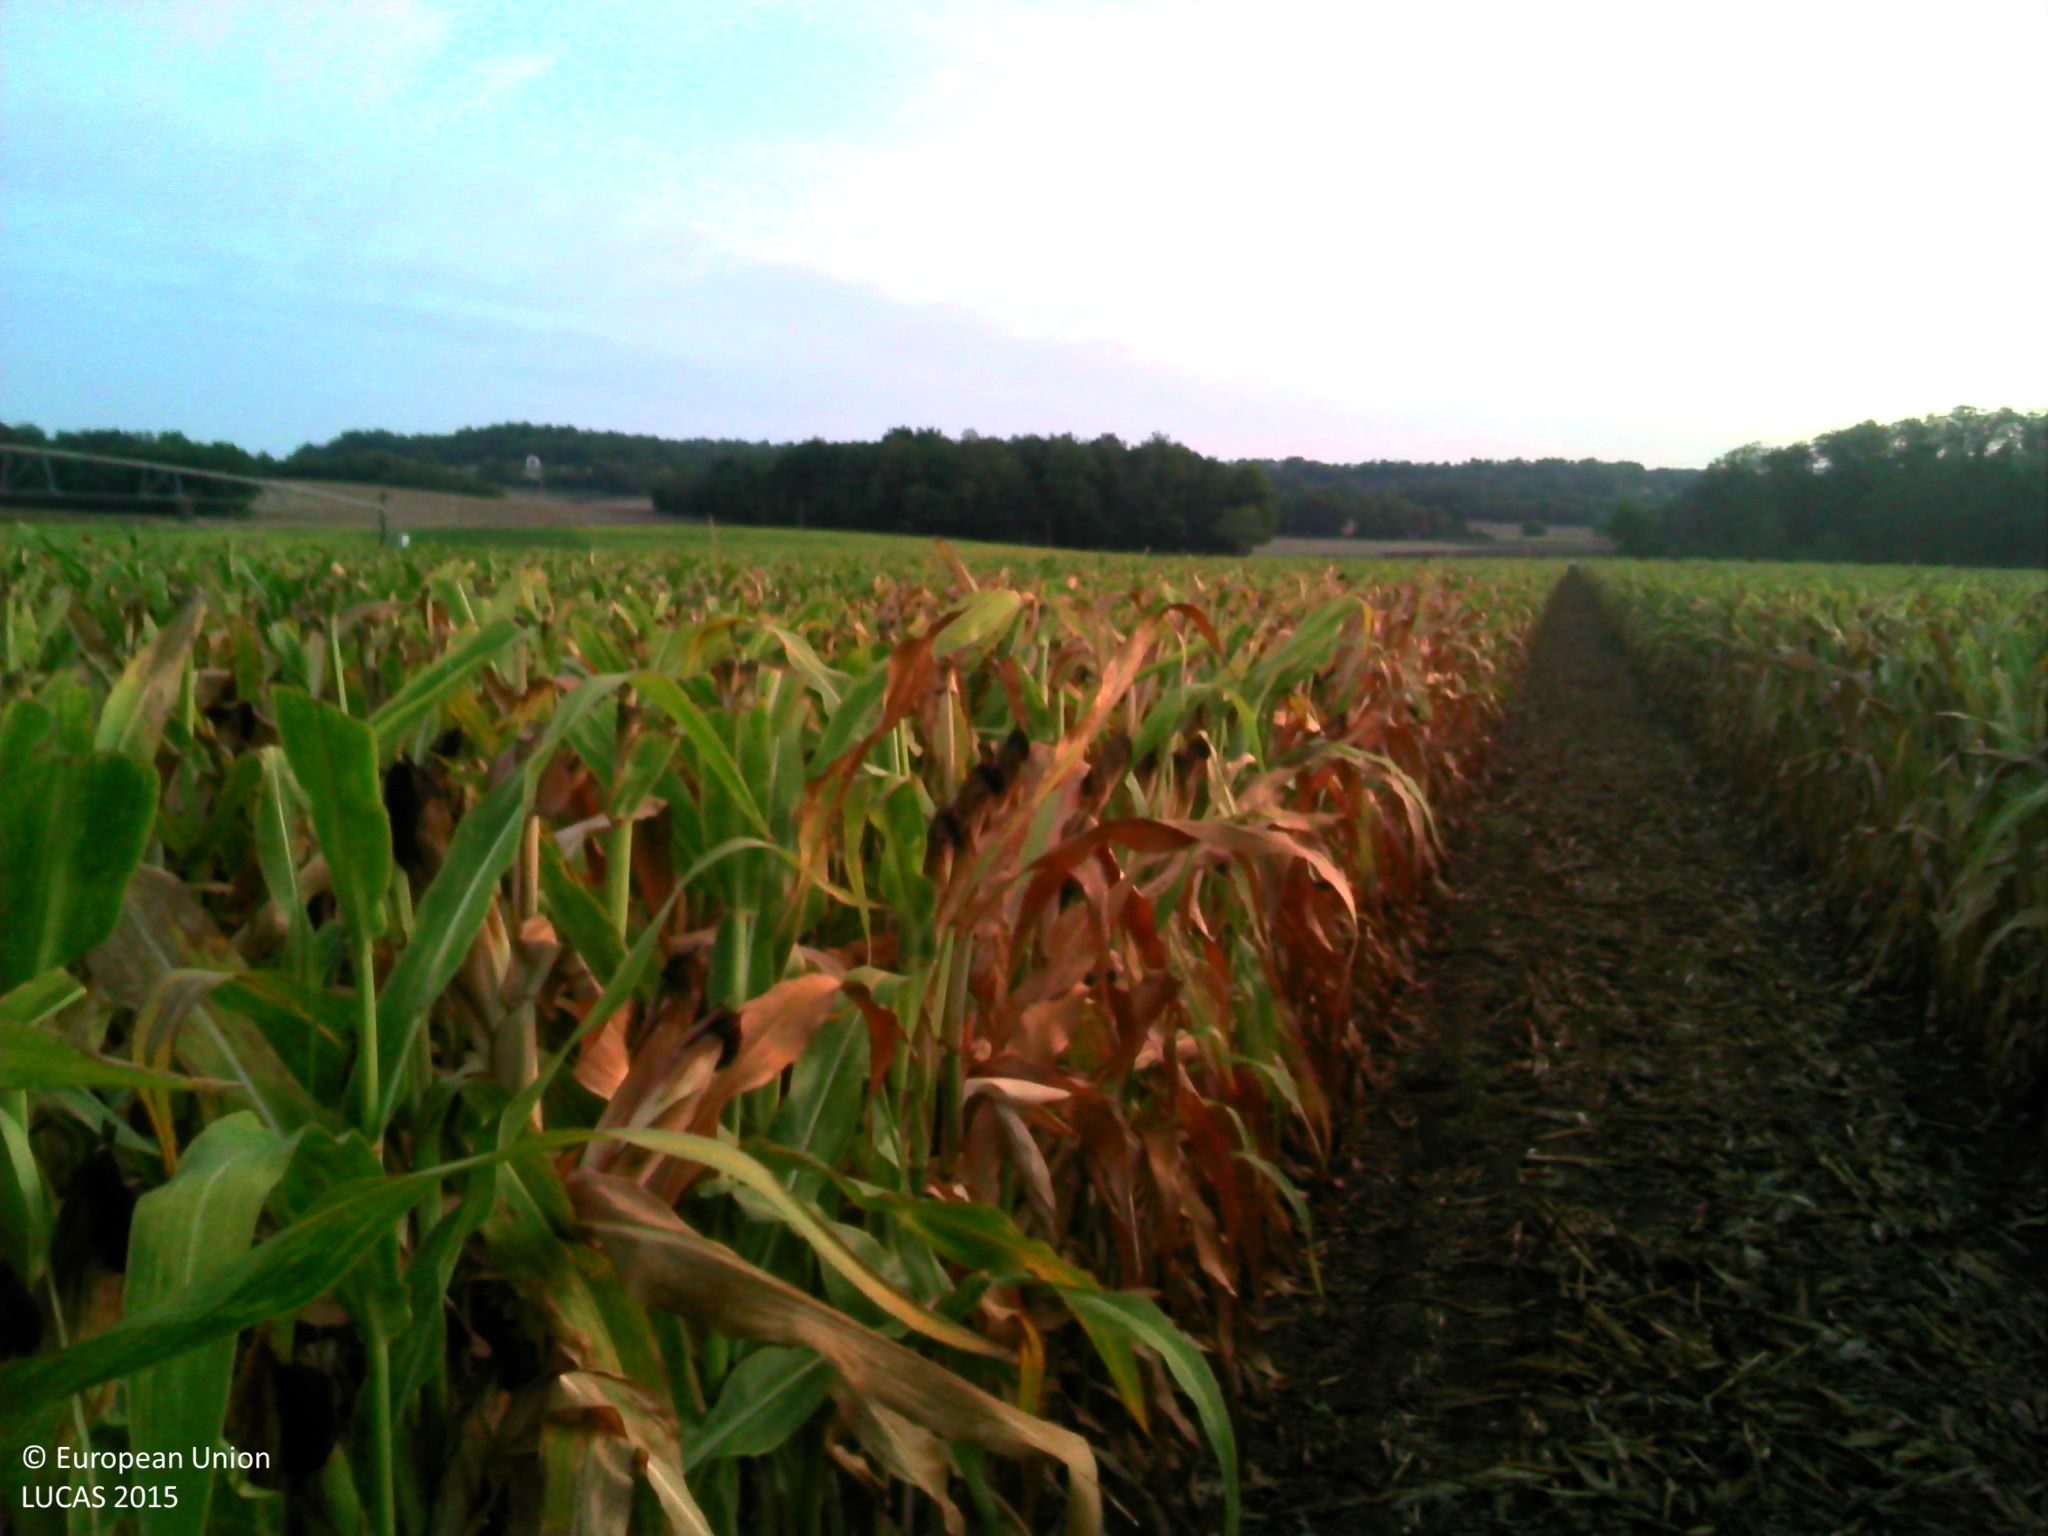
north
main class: Cropland
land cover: Maize
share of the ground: > 75 %
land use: Agriculture (excluding fallow land and kitchen gardens)
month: August
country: FR
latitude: 44.2855
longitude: 1.2135
